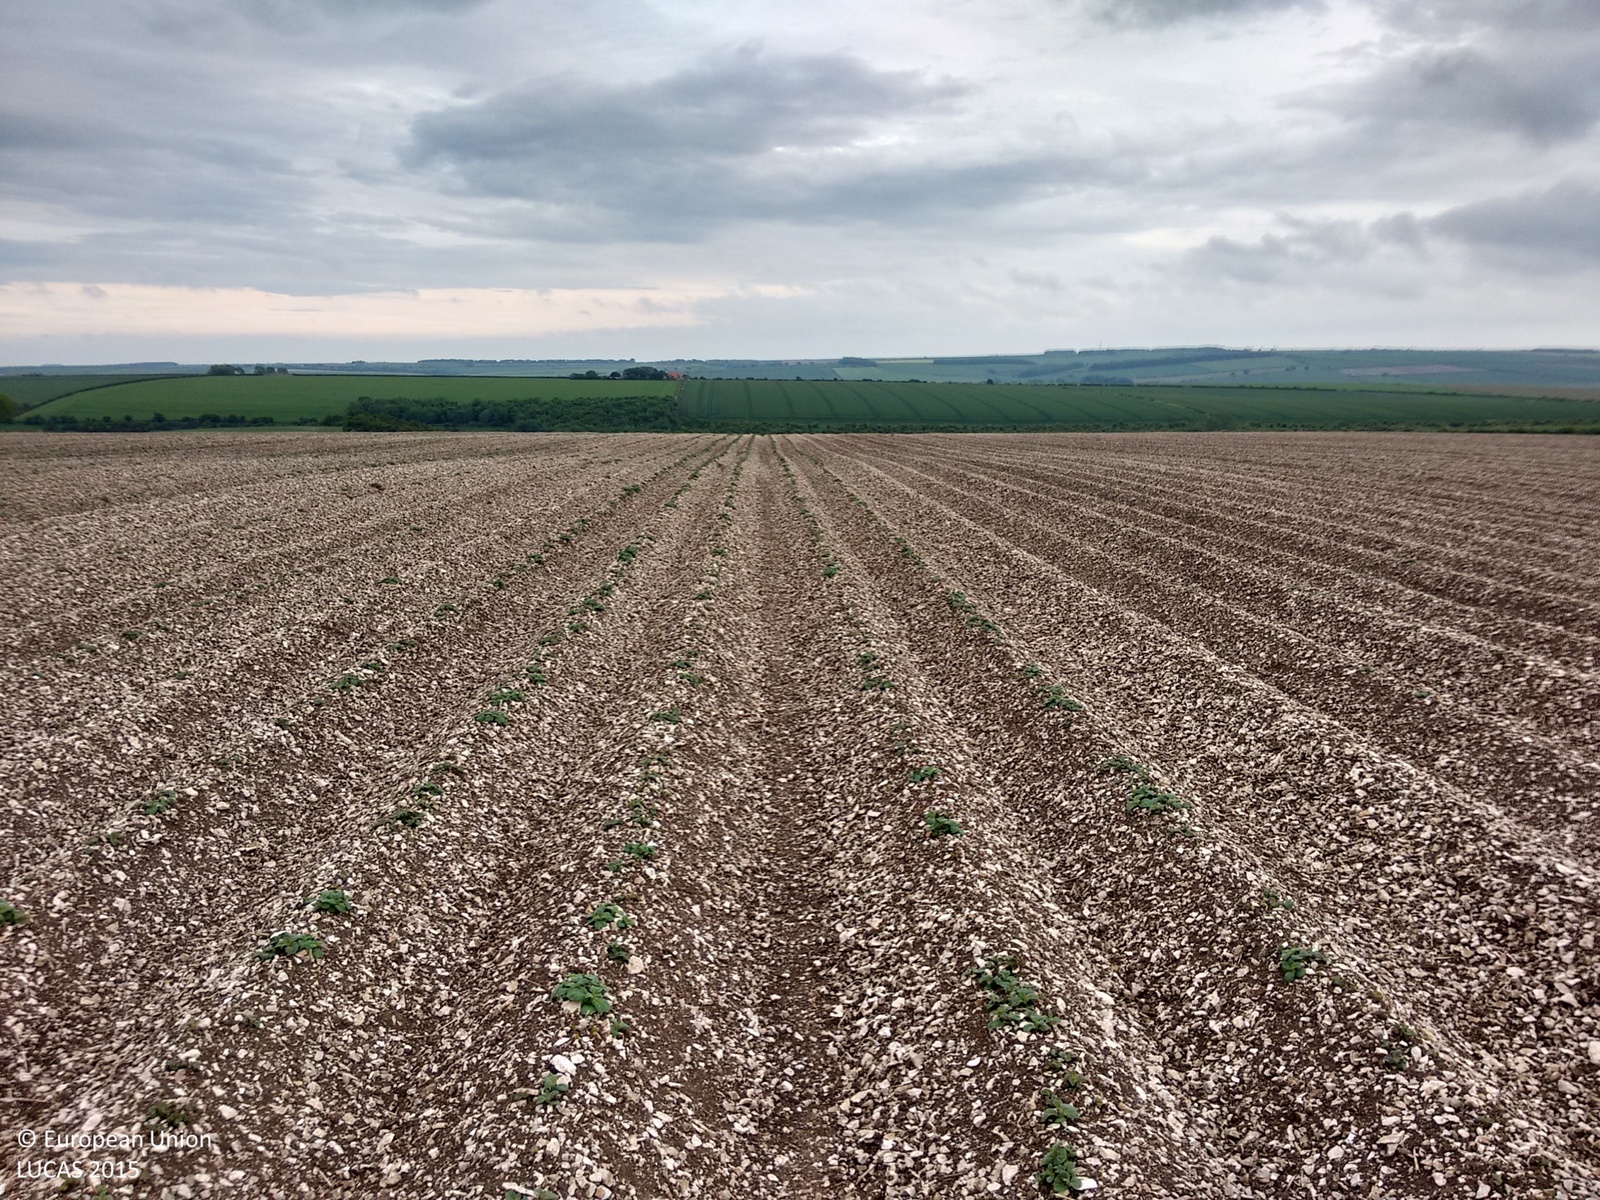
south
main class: Cropland
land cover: Potatoes
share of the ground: < 10 %
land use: Agriculture (excluding fallow land and kitchen gardens)
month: June
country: GB
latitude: 54.1649
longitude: -0.4353
